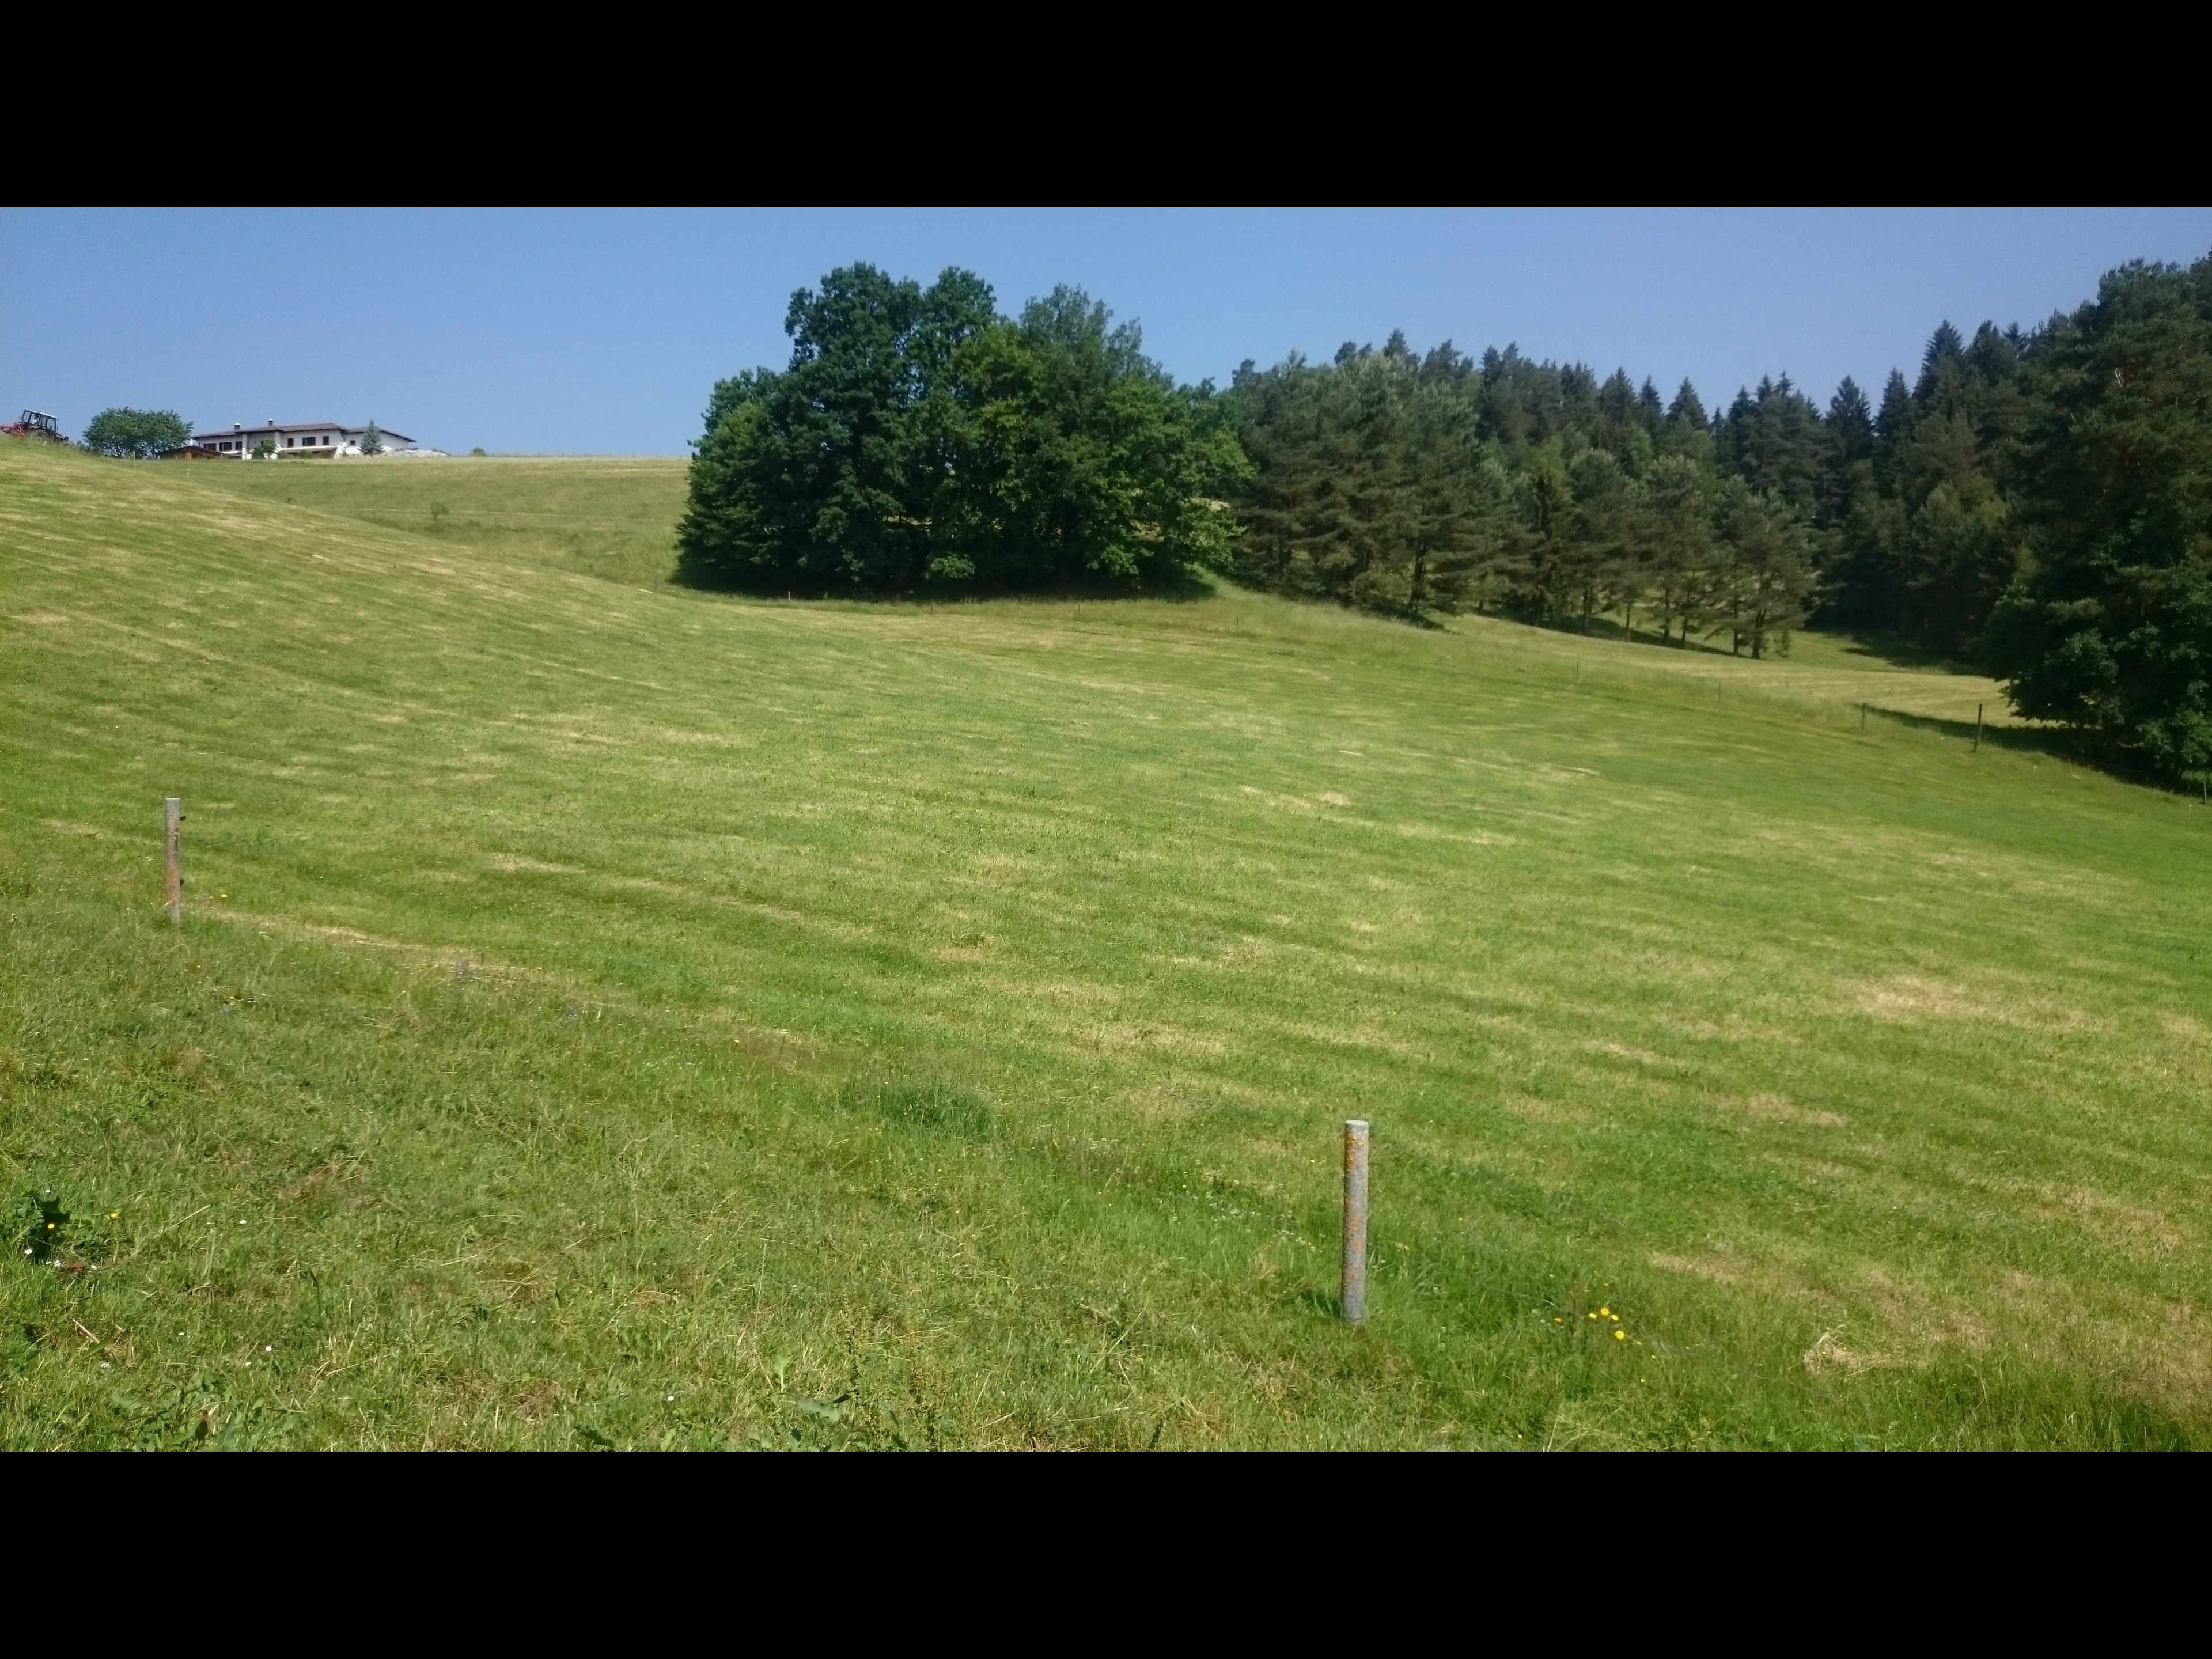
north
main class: Grassland
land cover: Grassland without tree/shrub cover
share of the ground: > 75 %
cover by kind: herbaceous plants 100 %
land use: Agriculture (excluding fallow land and kitchen gardens)
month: June
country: AT
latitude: 48.3965
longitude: 14.6334
